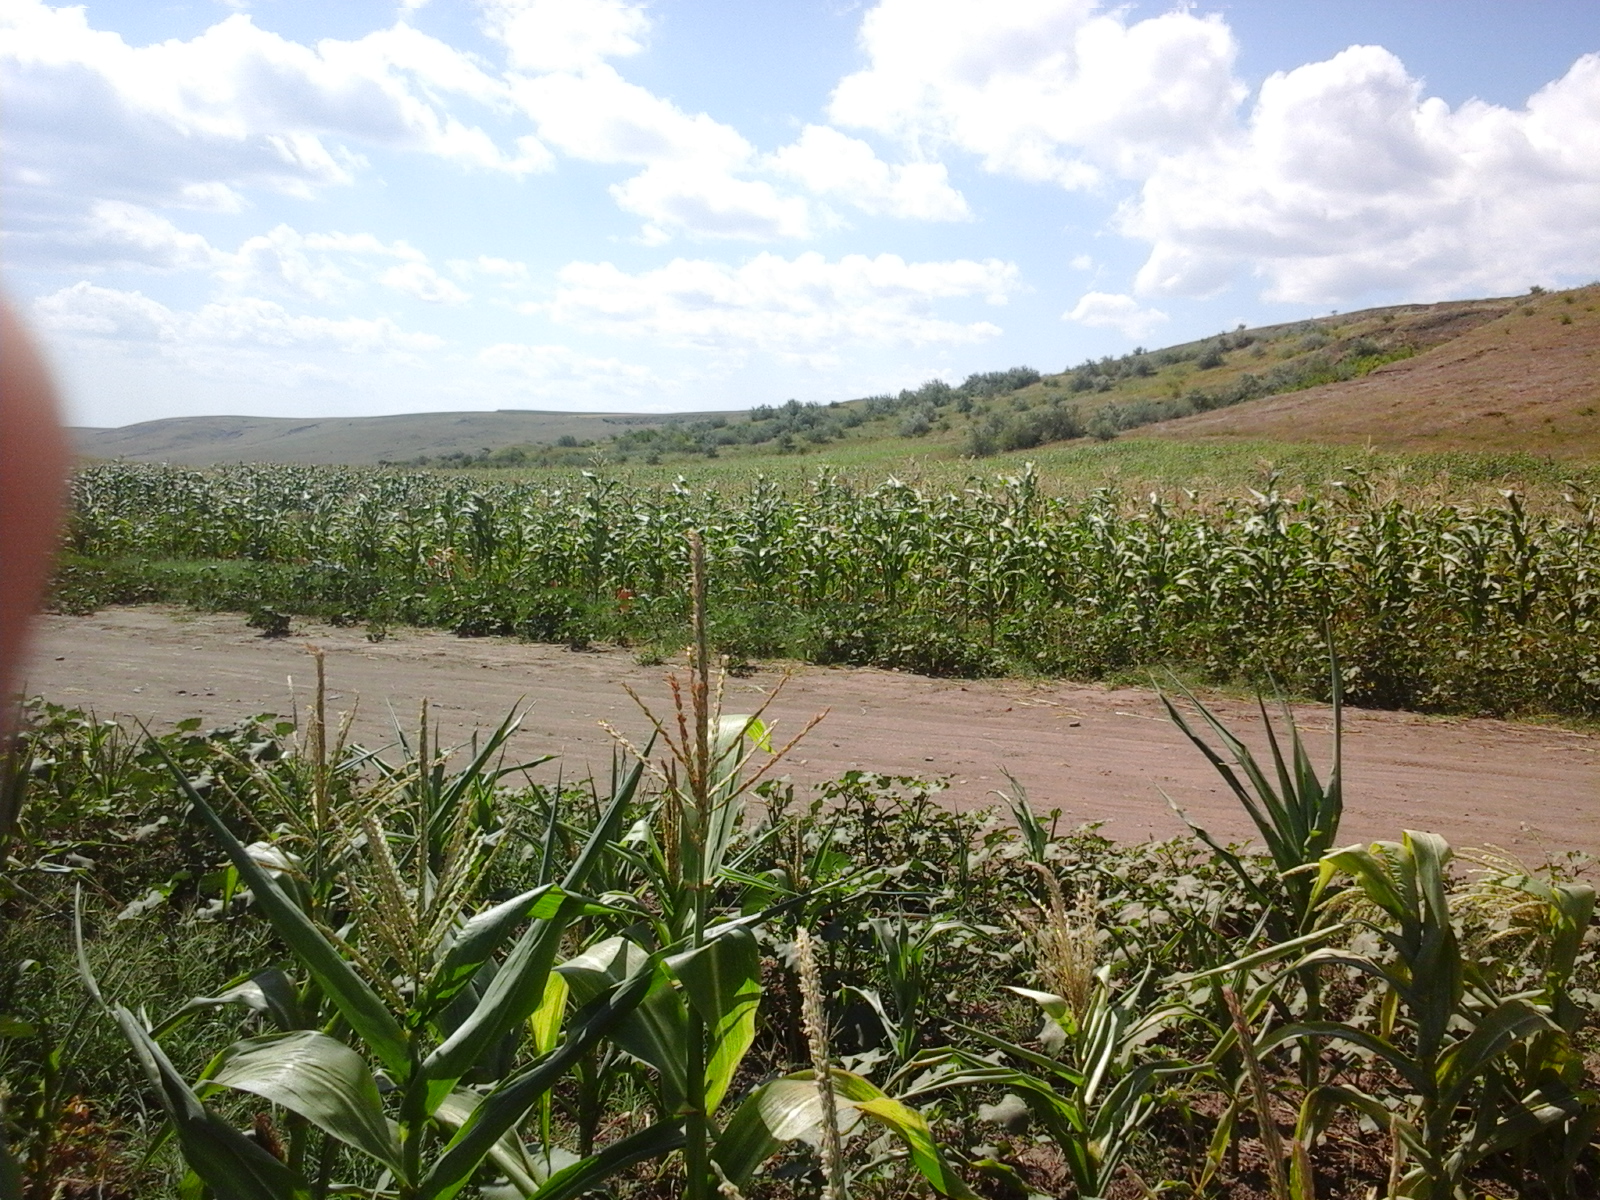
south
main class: Cropland
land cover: Maize
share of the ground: > 75 %
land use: Agriculture (excluding fallow land and kitchen gardens)
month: July
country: RO
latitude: 46.3529
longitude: 27.9129
